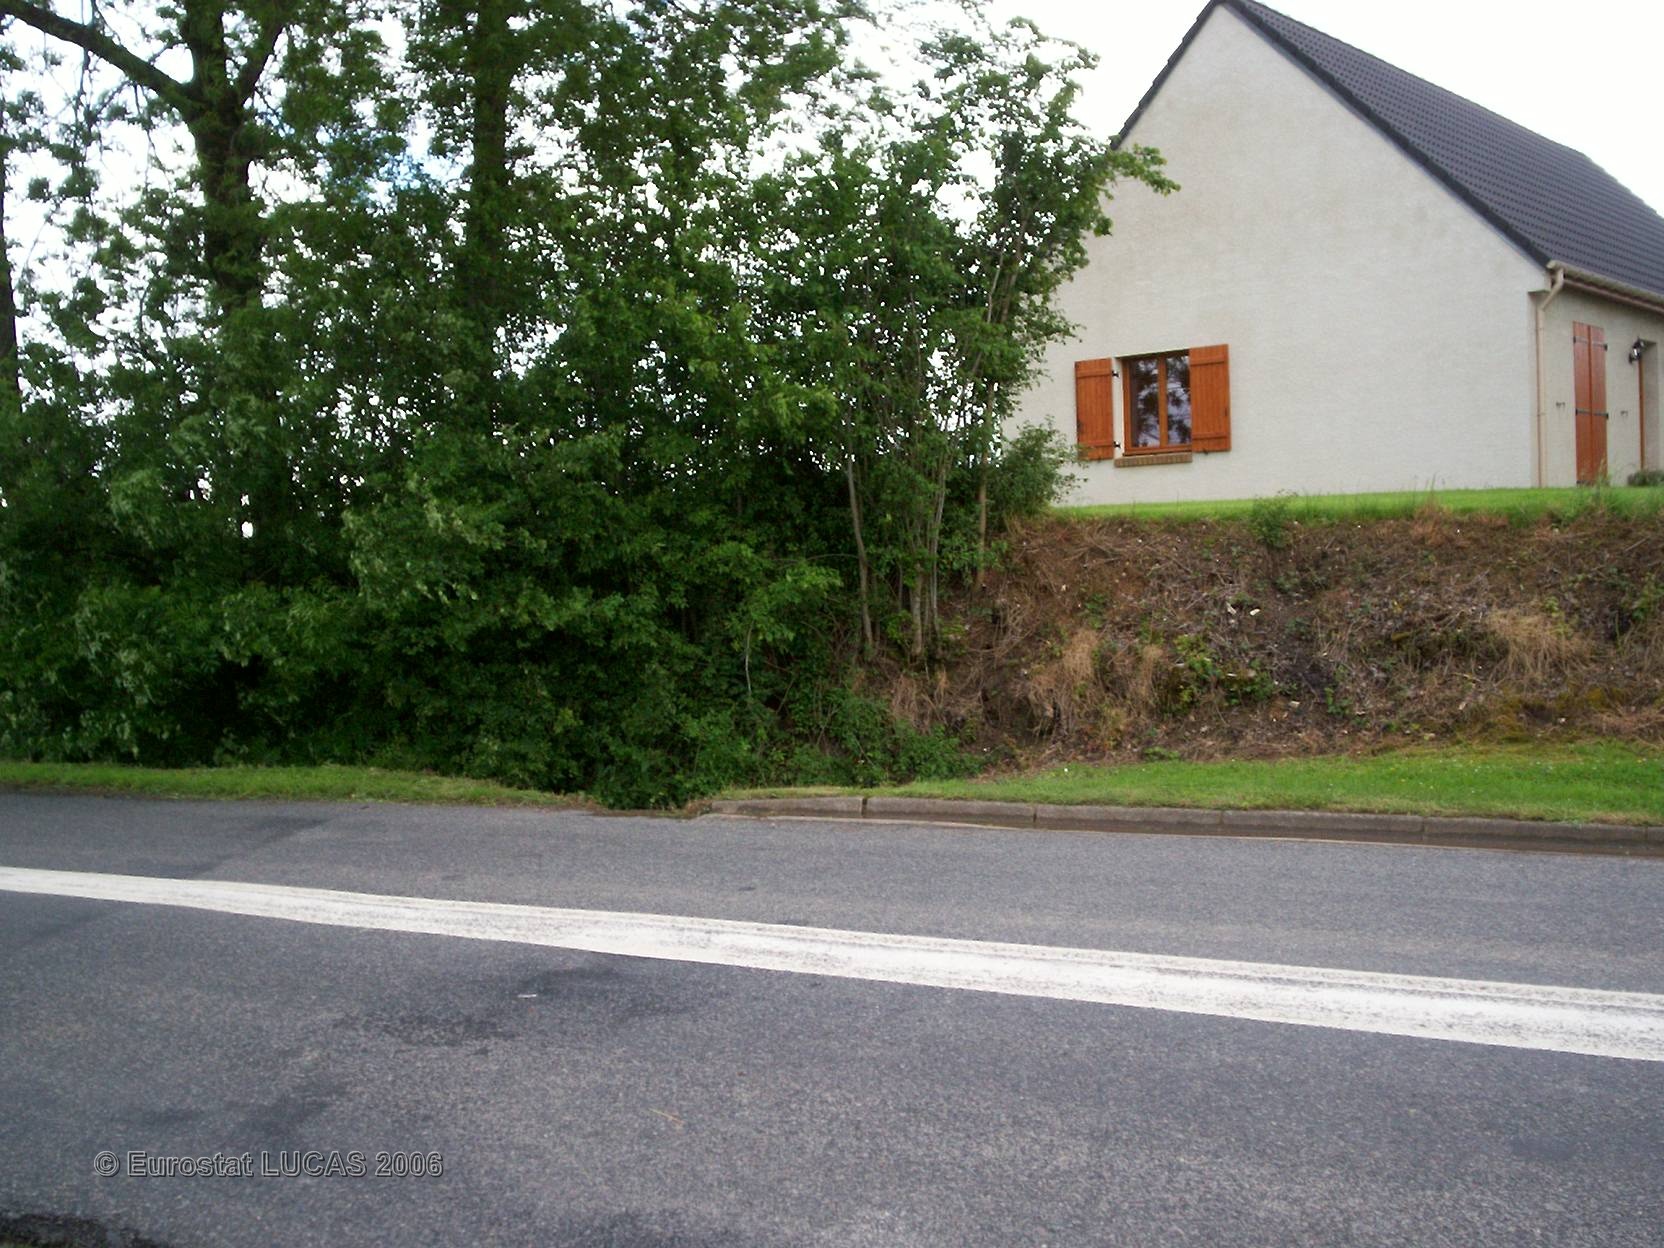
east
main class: Grassland
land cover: Grassland with sparse tree/shrub cover
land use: Agriculture (excluding fallow land and kitchen gardens)
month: May
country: FR
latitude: 50.1825
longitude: 2.6641
